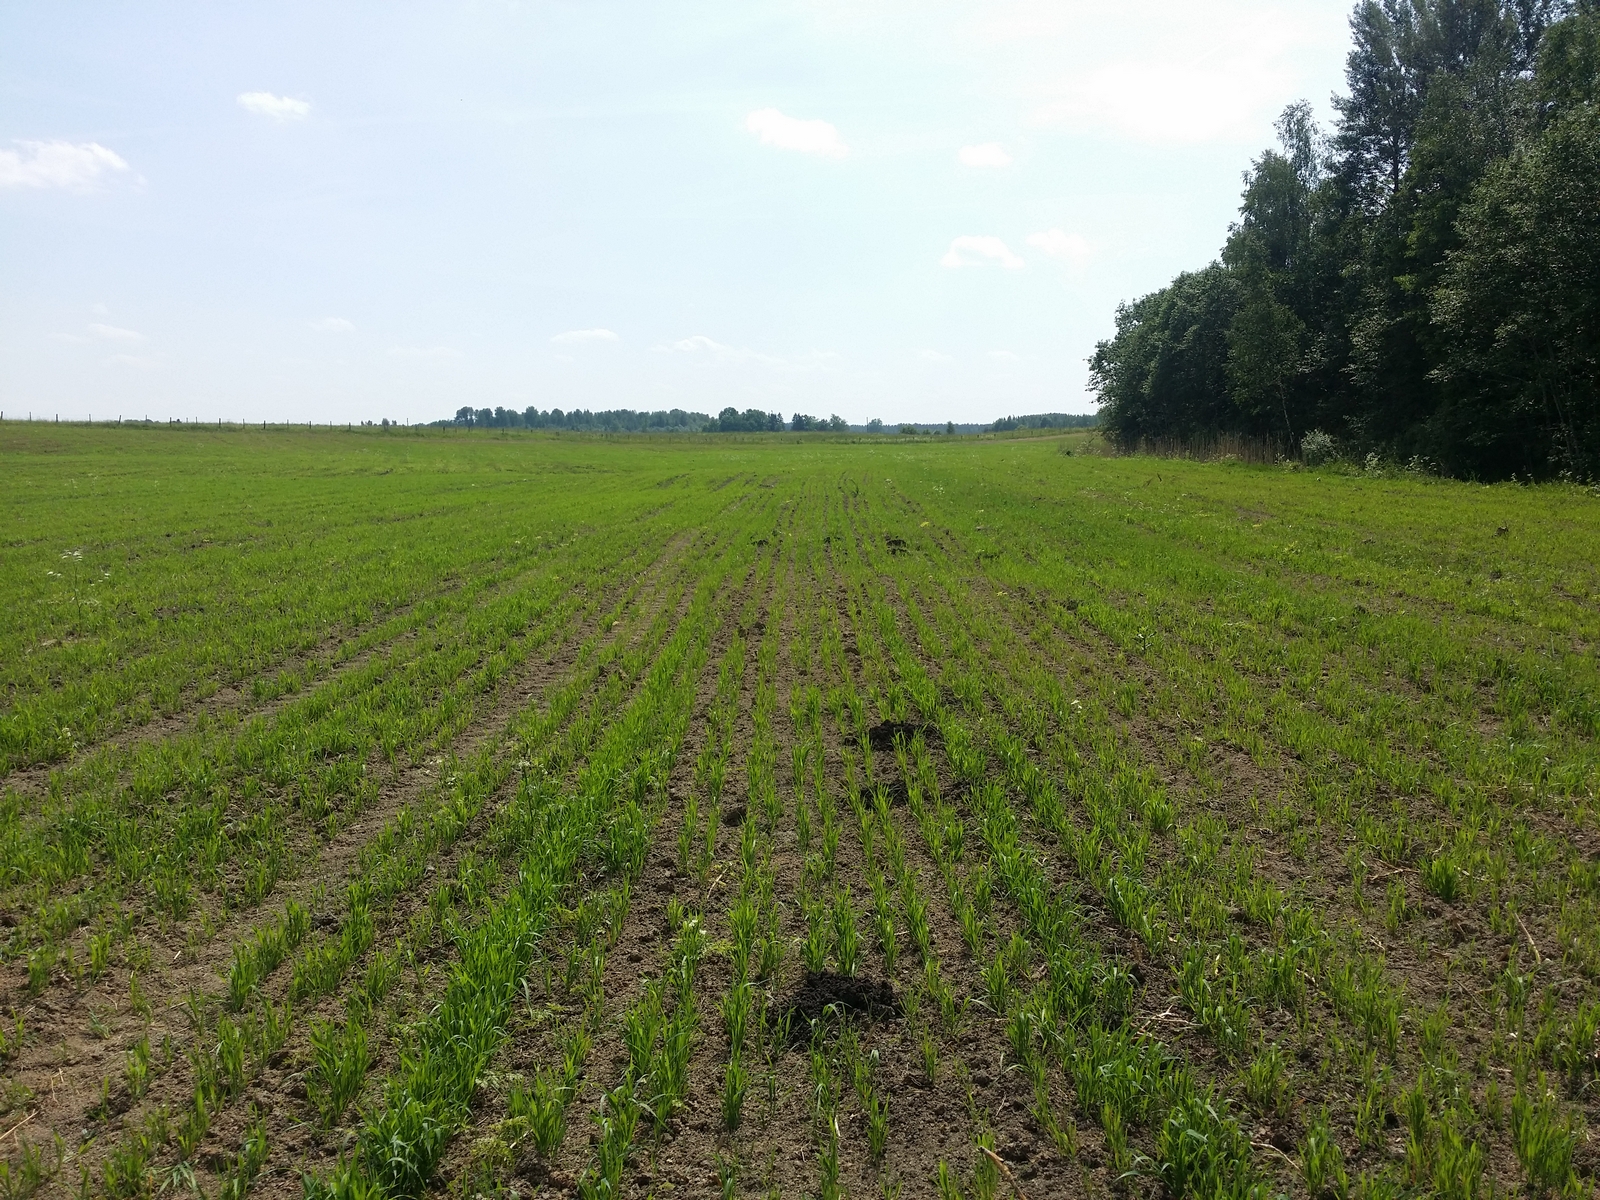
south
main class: Cropland
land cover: Oats
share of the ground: 10 - 25 %
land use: Agriculture (excluding fallow land and kitchen gardens)
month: June
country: LV
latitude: 57.4437
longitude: 26.5219
